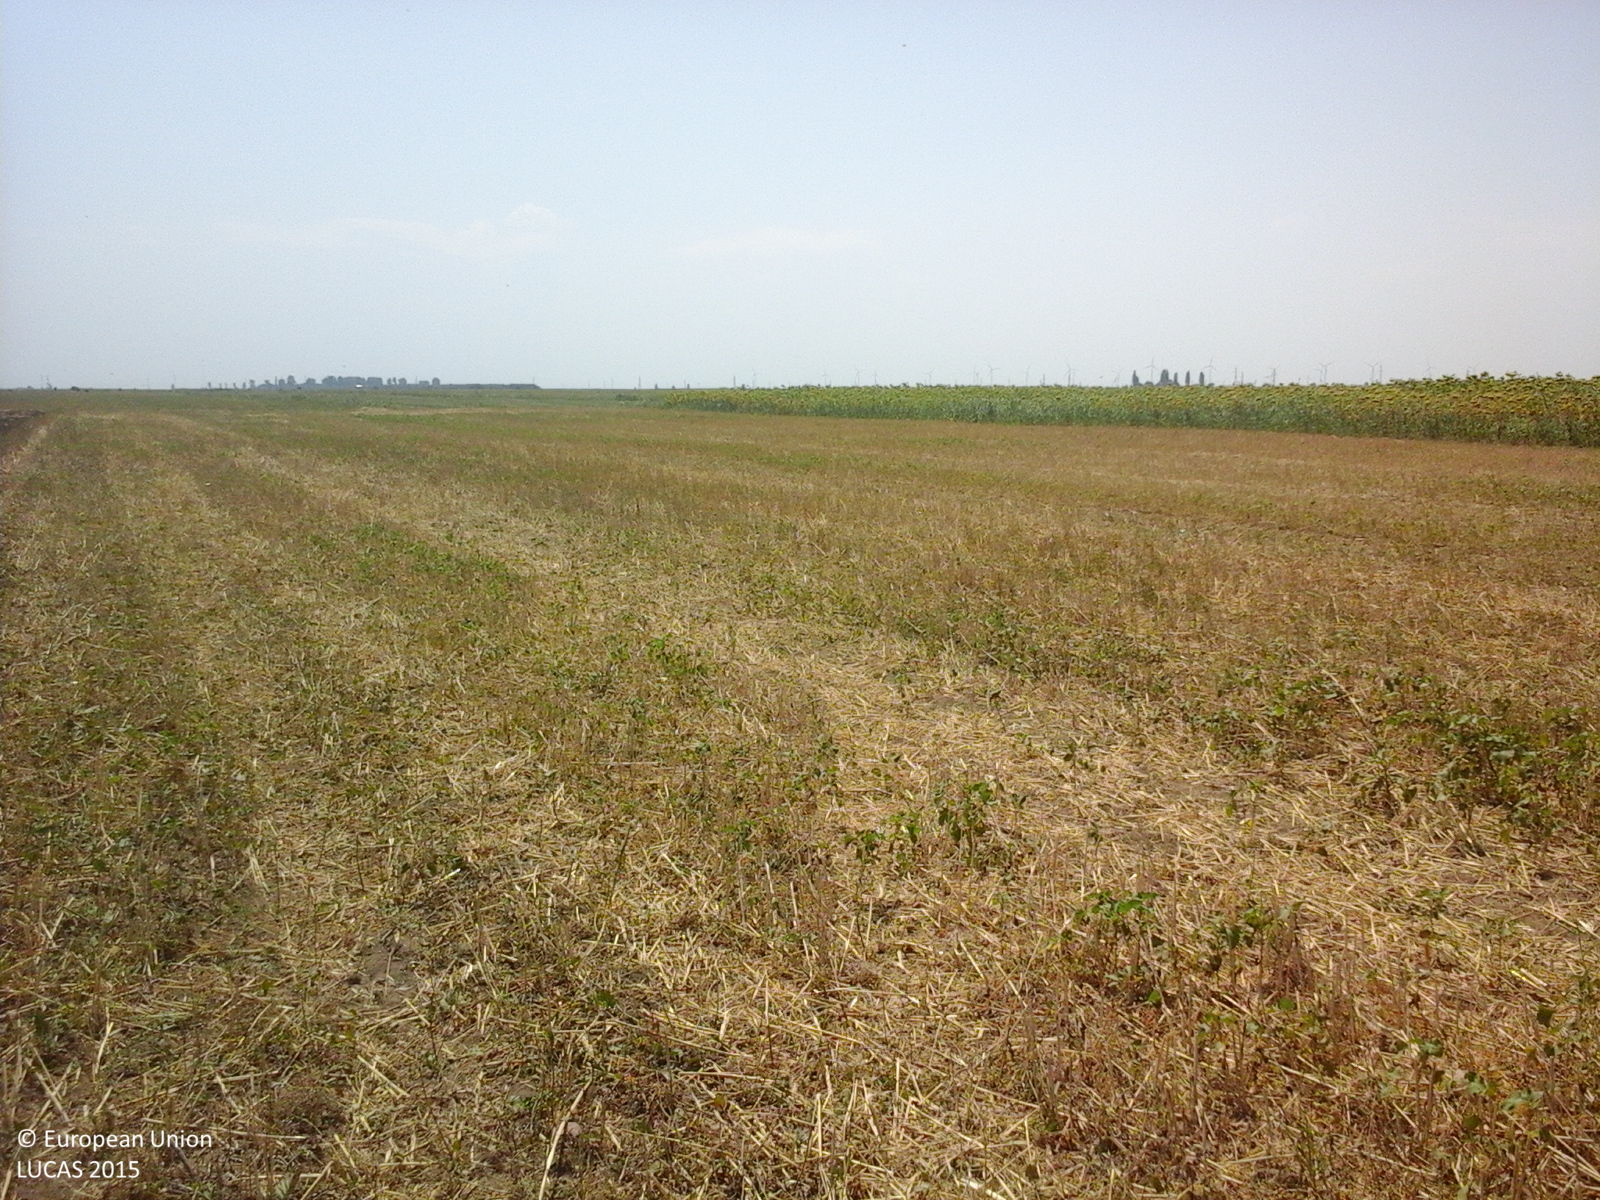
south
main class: Cropland
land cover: Barley
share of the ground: 25 - 50 %
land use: Agriculture (excluding fallow land and kitchen gardens)
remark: Harvested field
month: August
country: RO
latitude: 45.3338
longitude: 27.7295
